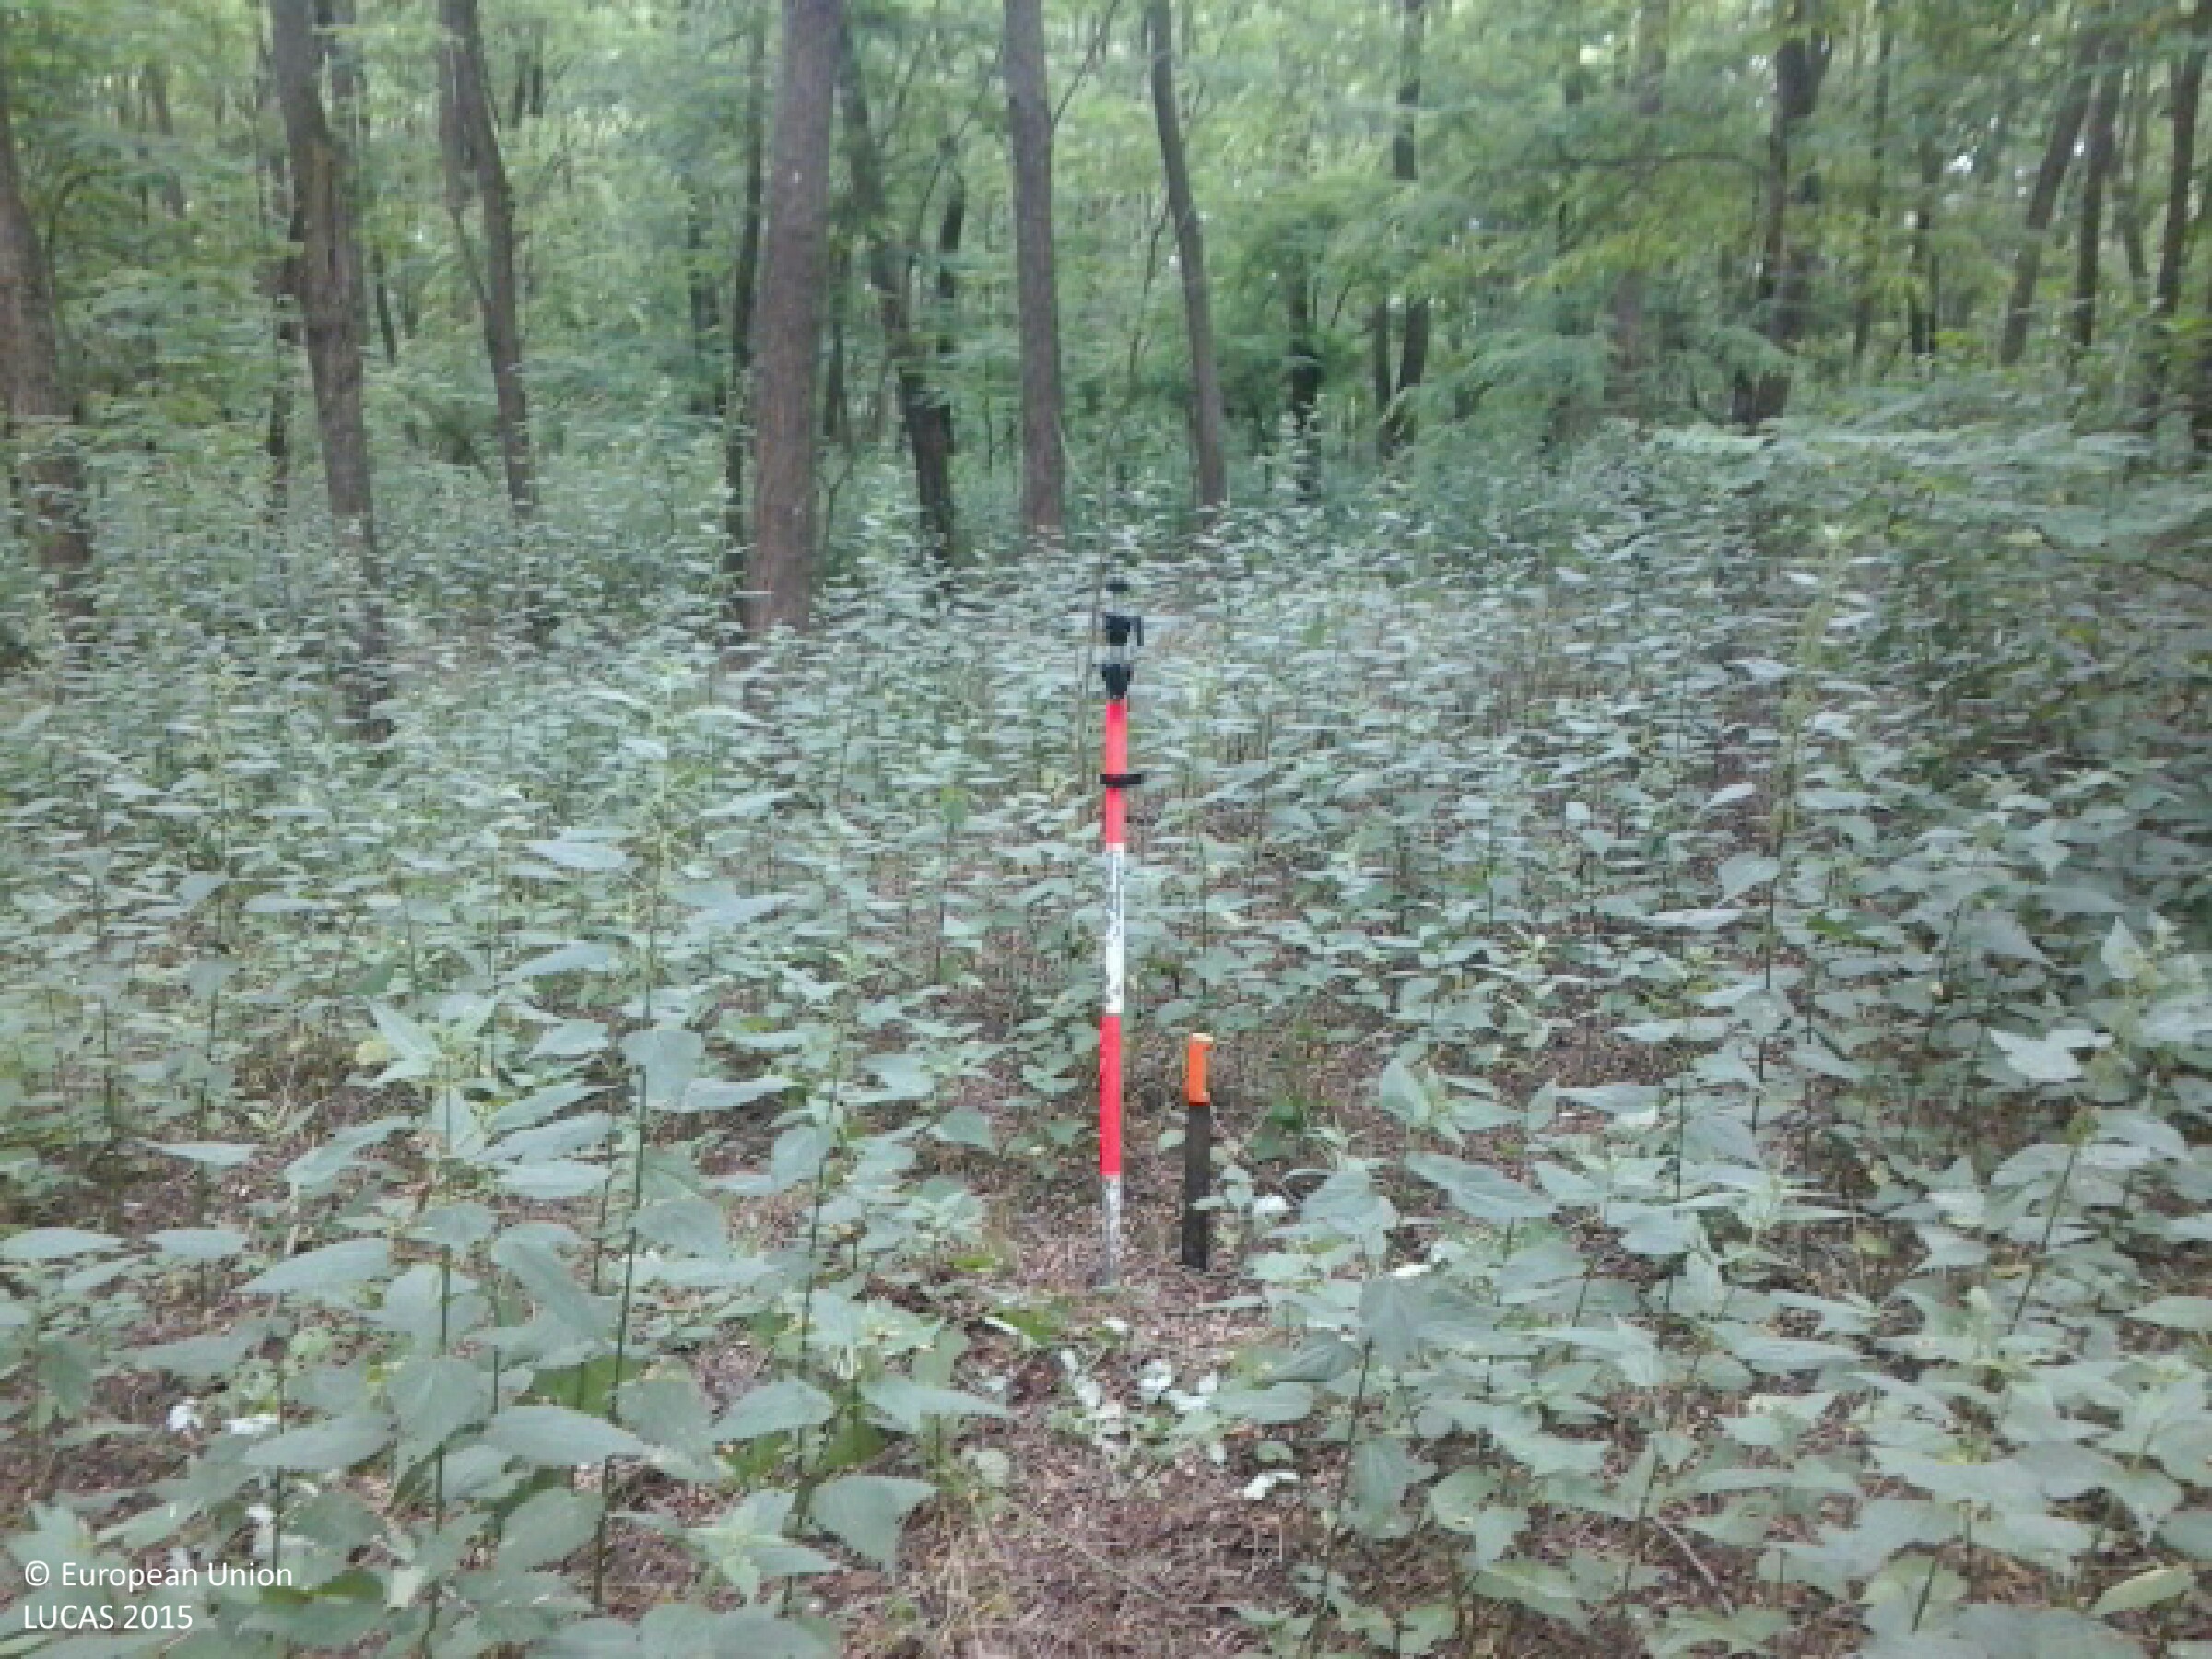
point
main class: Woodland
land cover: Broadleaved woodland
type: mesophytic deciduous forest
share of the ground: > 75 %
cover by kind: broadleaved forest trees 95 %, herbaceous plants 5 %
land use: Forestry
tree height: > 5 m
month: June
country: HU
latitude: 47.9731
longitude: 22.0960
